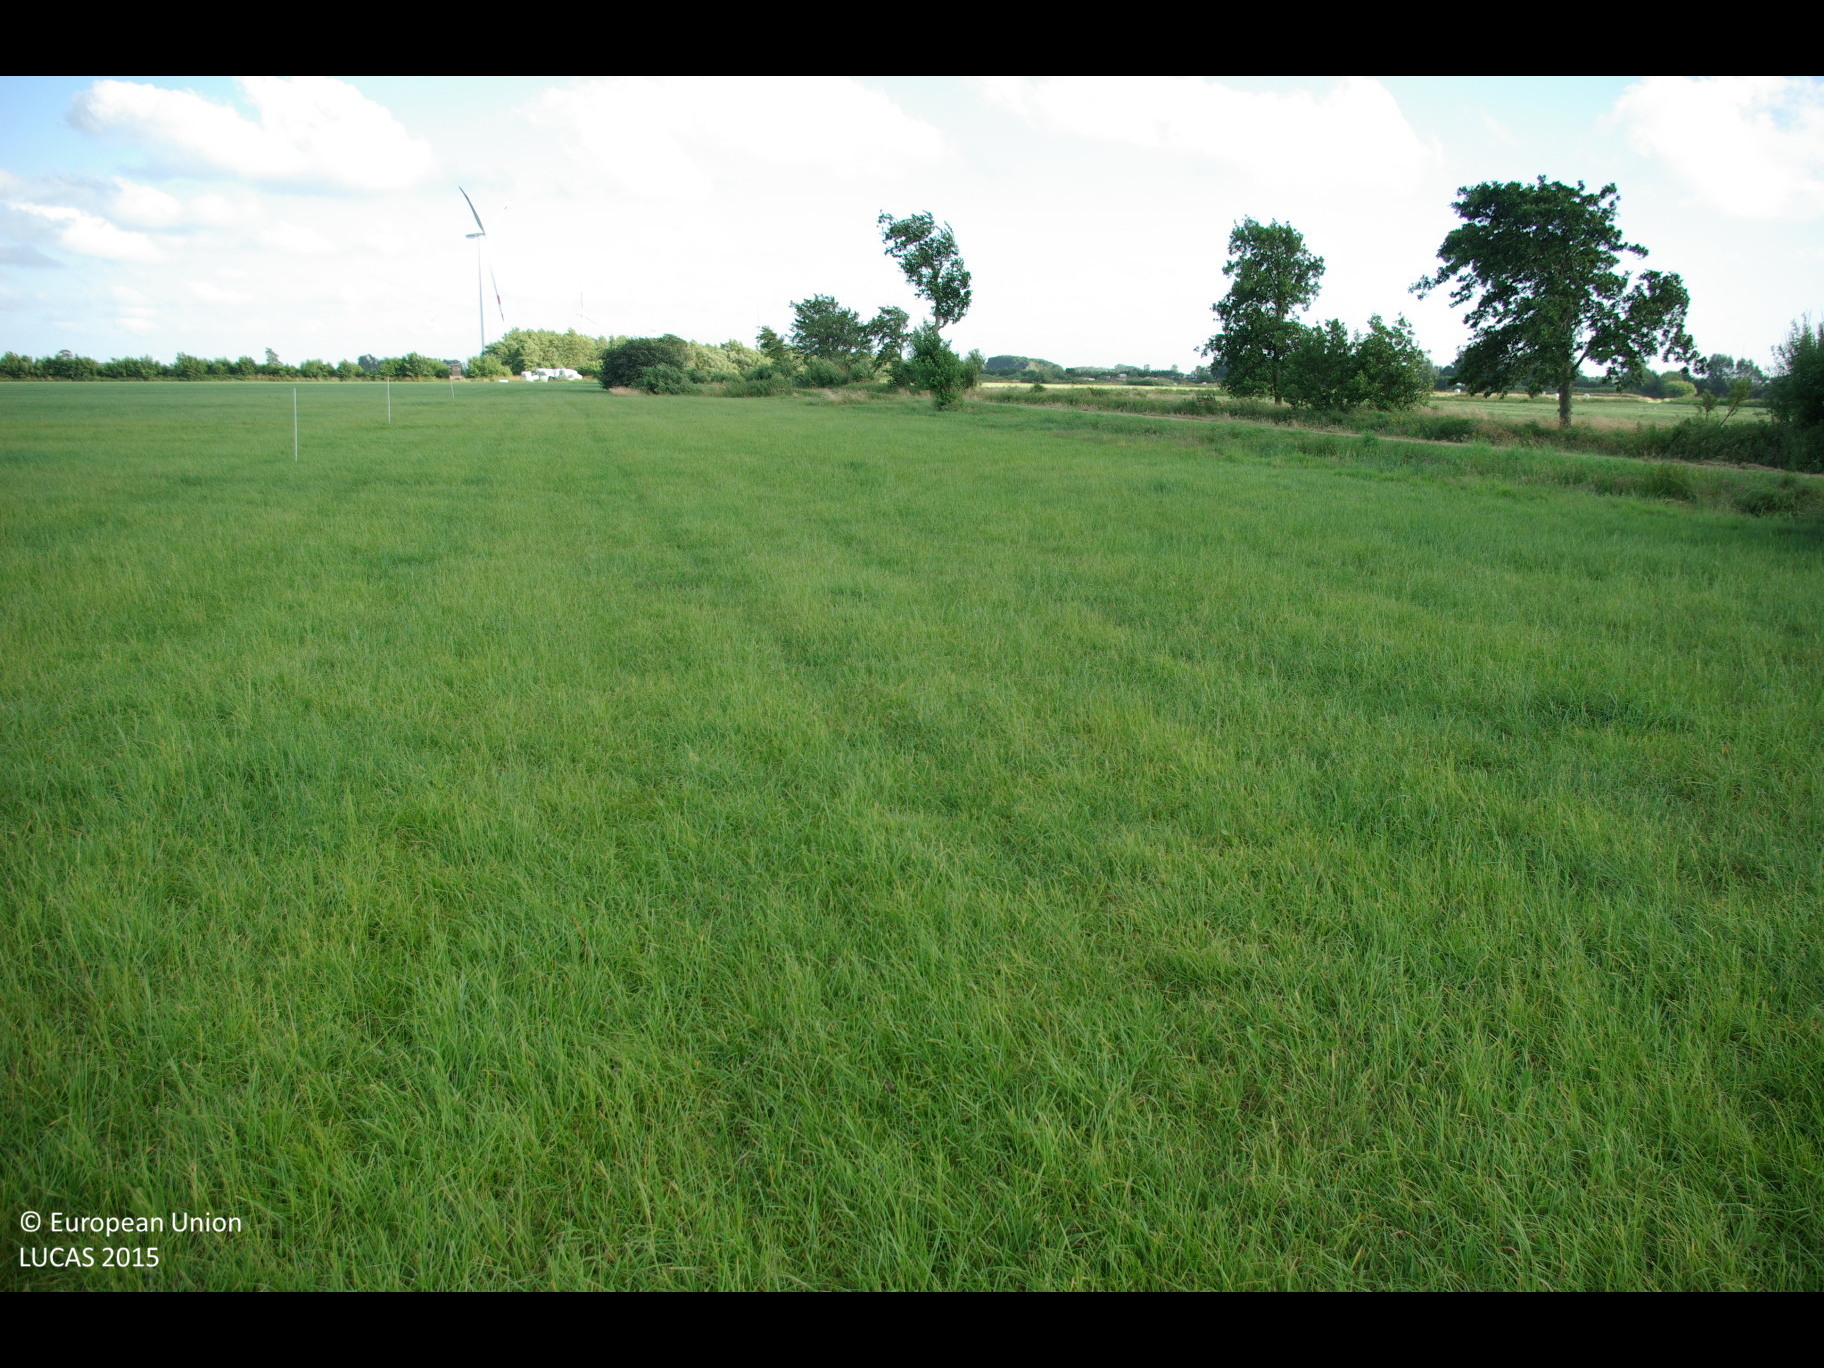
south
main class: Grassland
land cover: Grassland without tree/shrub cover
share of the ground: > 75 %
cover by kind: herbaceous plants 100 %
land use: Agriculture (excluding fallow land and kitchen gardens)
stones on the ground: < 10 %
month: July
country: DE
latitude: 54.6580
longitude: 9.3029
